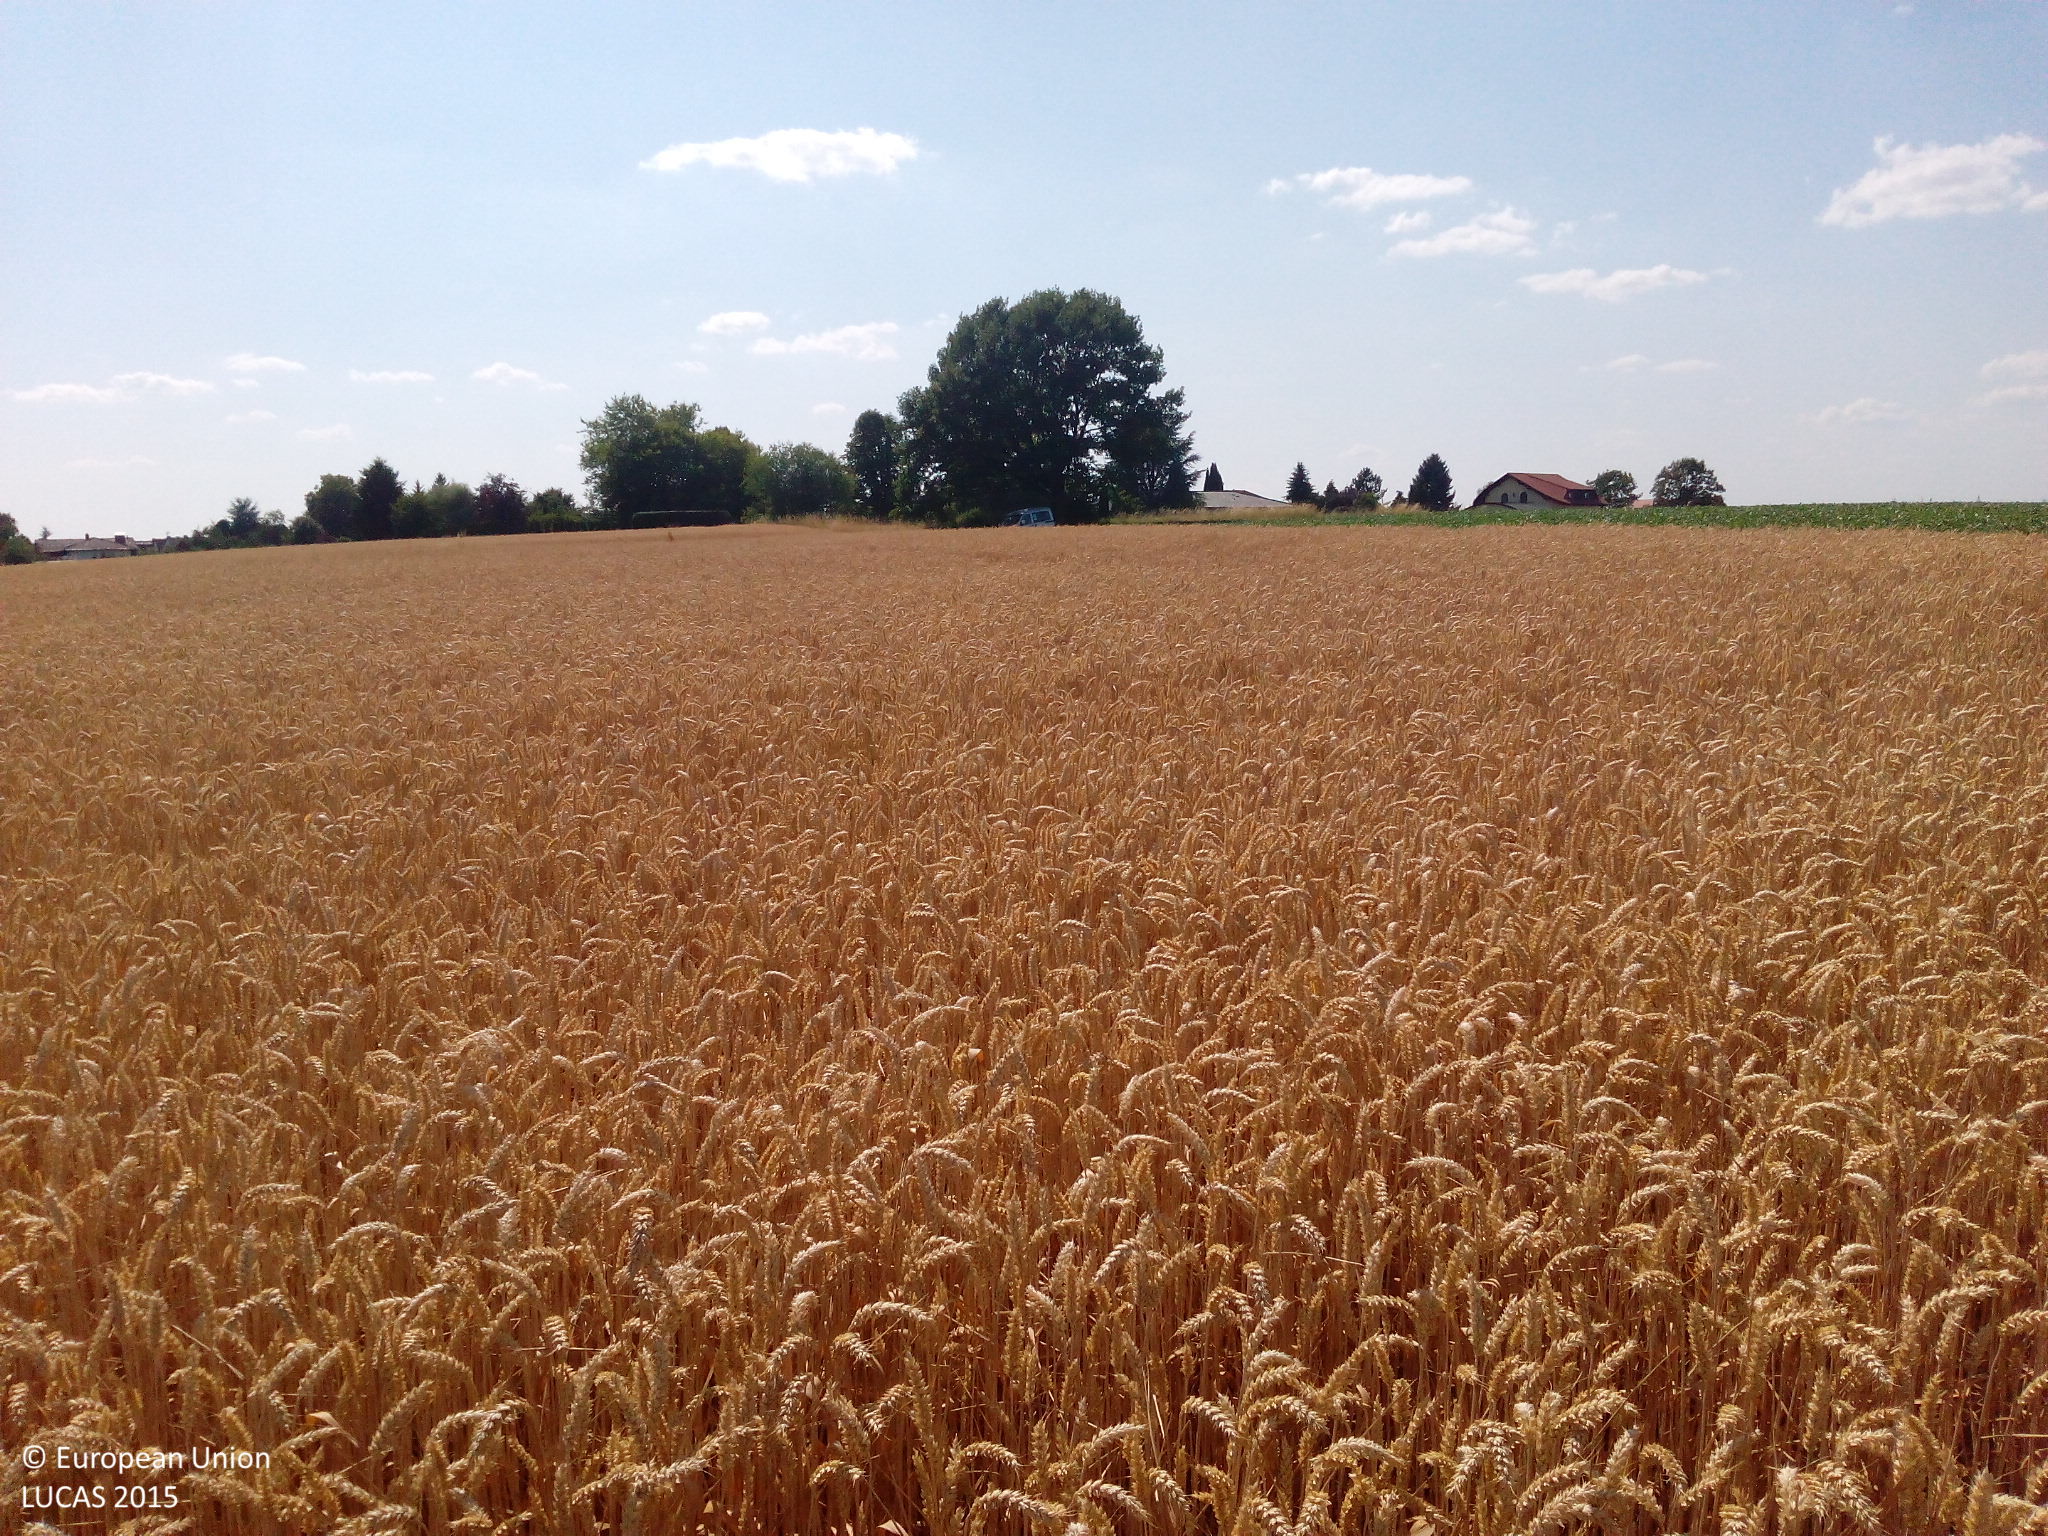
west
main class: Cropland
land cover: Common wheat
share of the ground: > 75 %
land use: Agriculture (excluding fallow land and kitchen gardens)
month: July
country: DE
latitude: 49.2048
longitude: 7.5712
